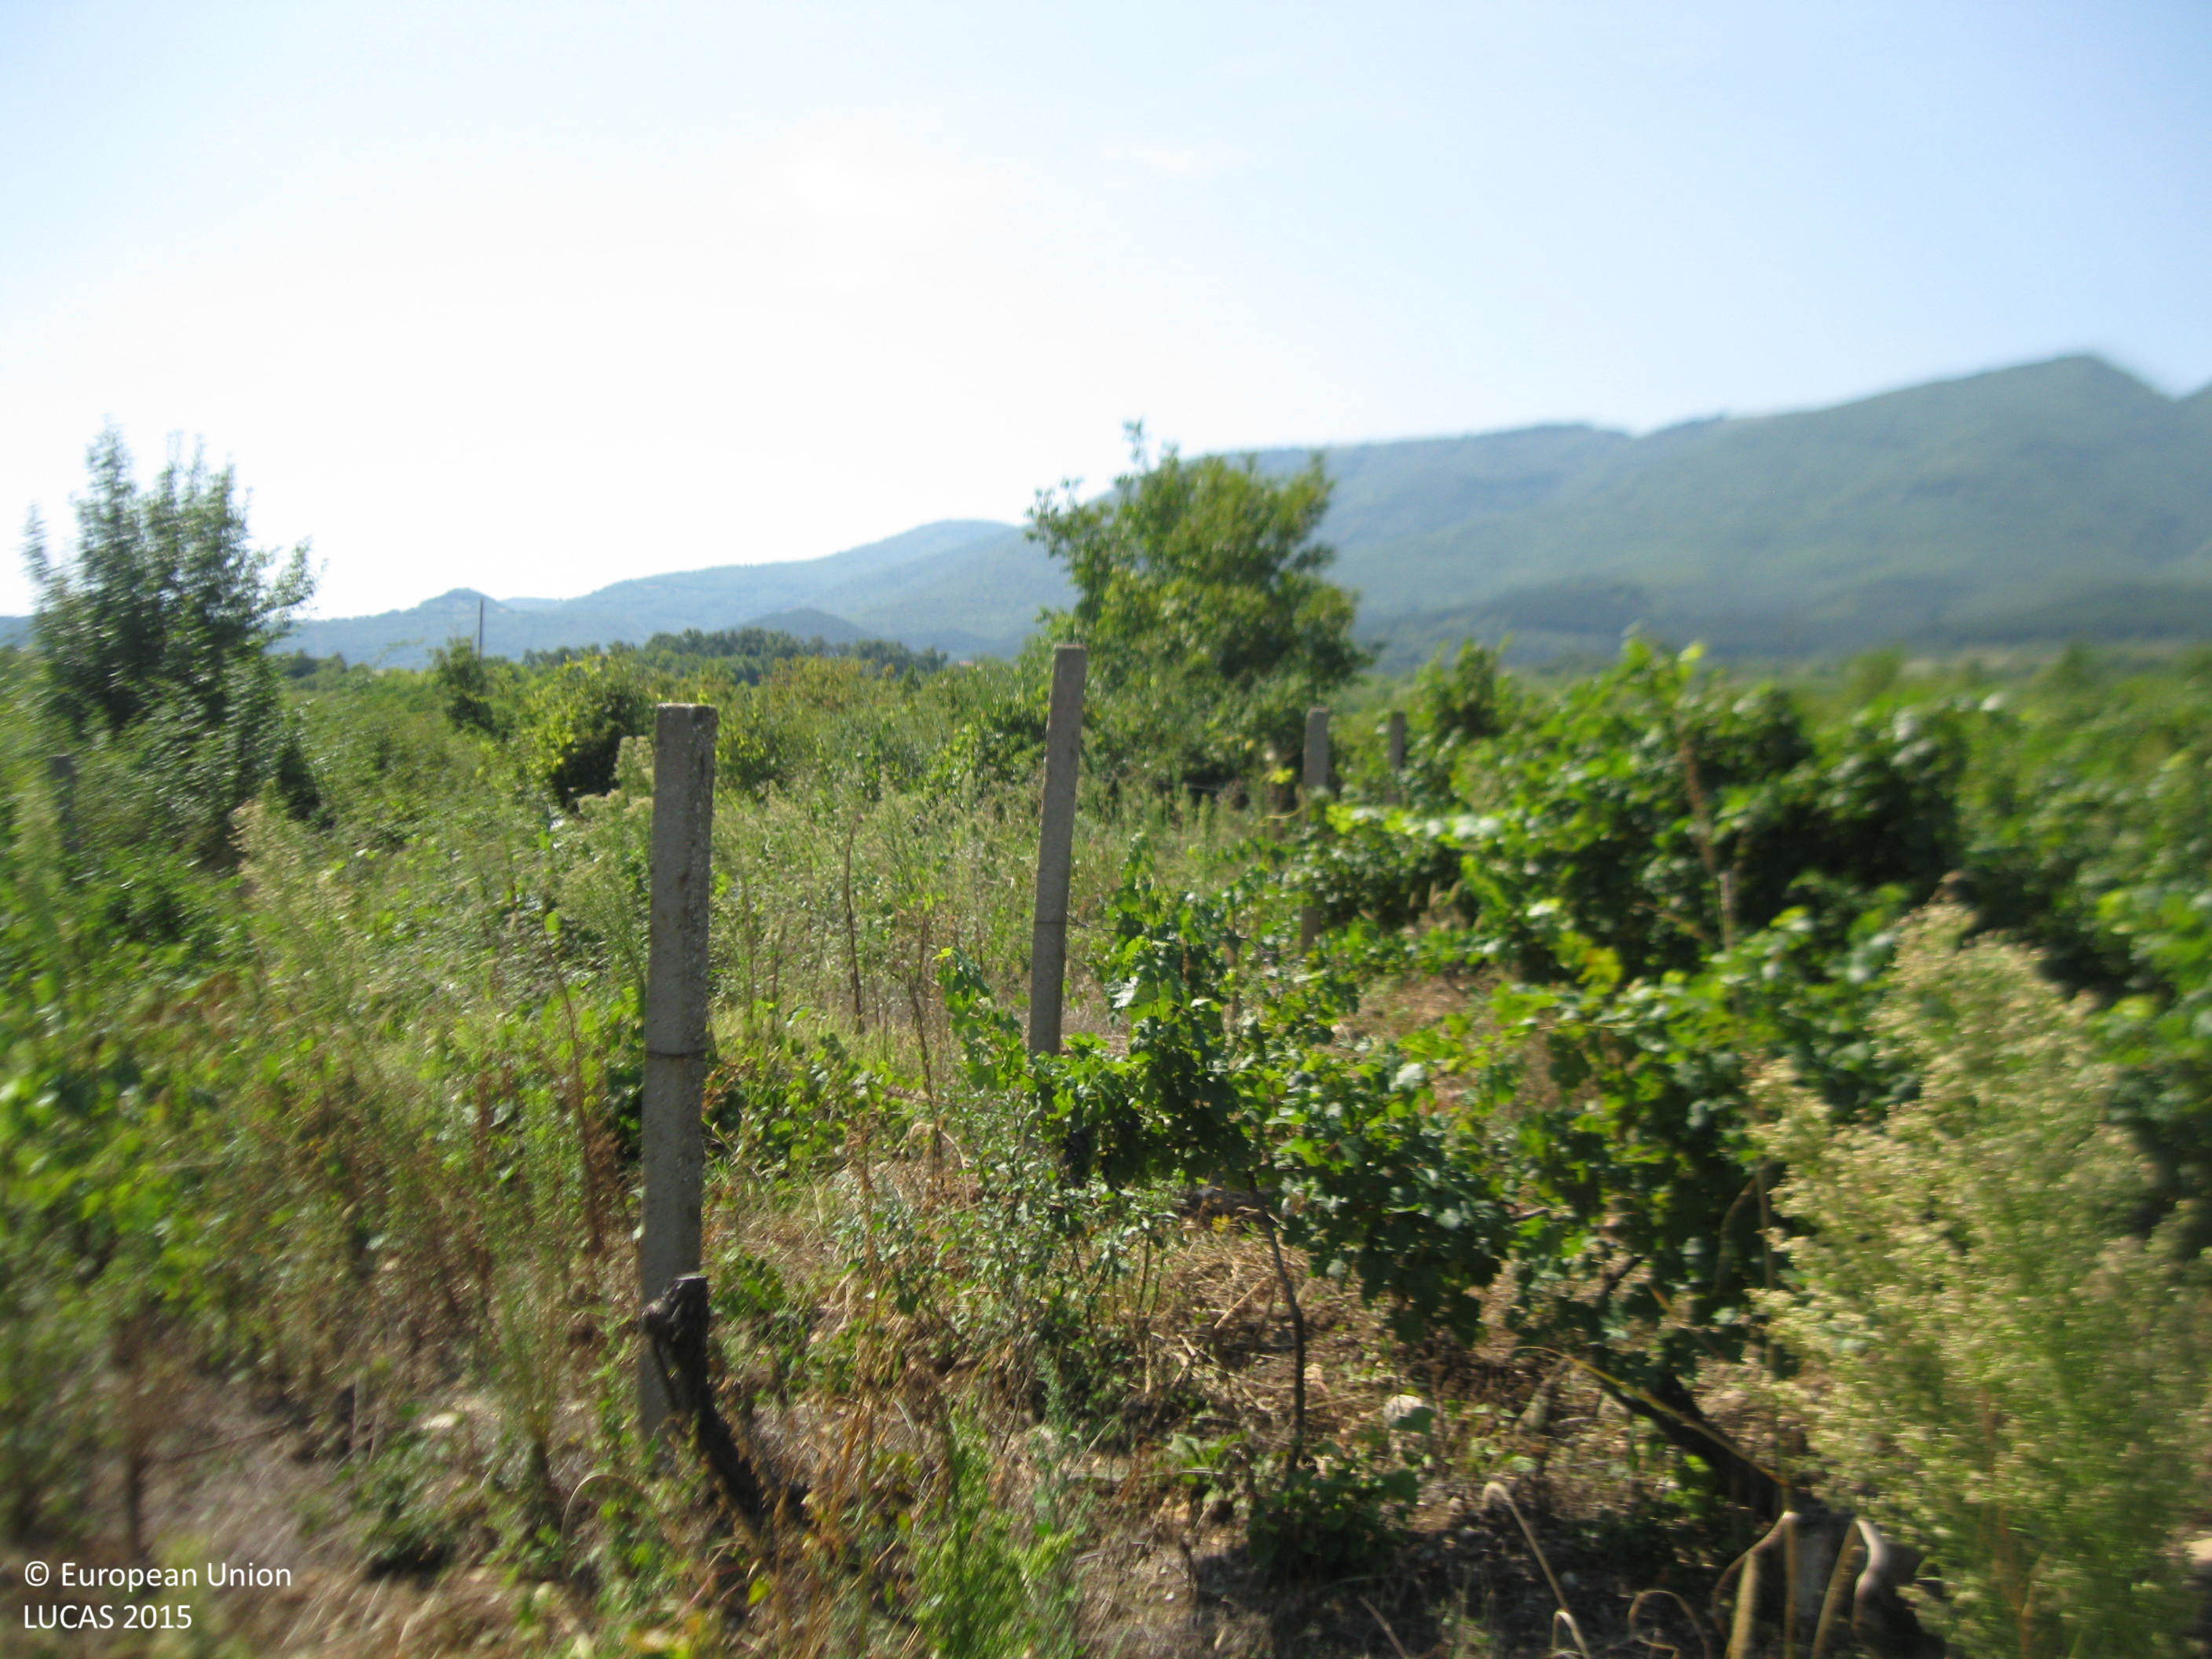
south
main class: Cropland
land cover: Vineyards
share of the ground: 25 - 50 %
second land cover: Spontaneously vegetated surfaces
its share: 50 - 75 %
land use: Agriculture (excluding fallow land and kitchen gardens)
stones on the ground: 10 - 25 %
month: August
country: BG
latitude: 41.9373
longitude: 24.9724
